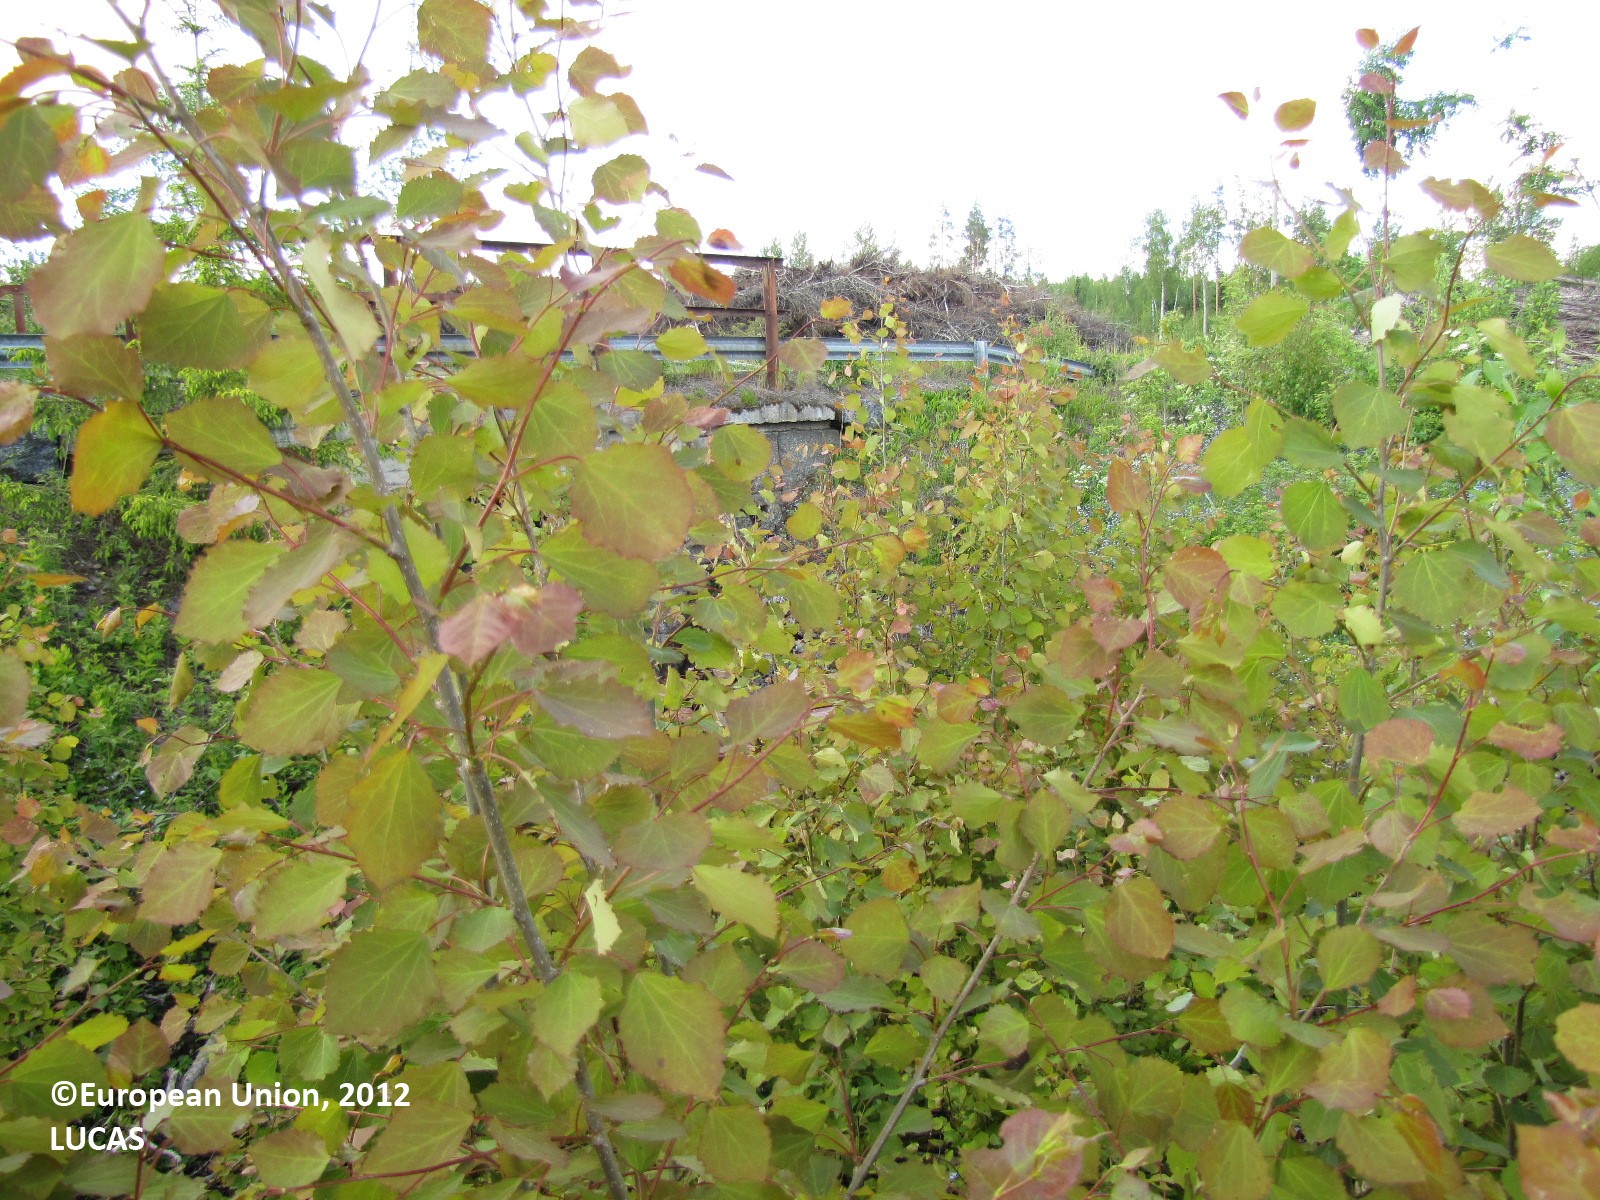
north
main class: Woodland
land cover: Broadleaved woodland
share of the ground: 25 - 50 %
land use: Semi-natural and natural areas not in use
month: June
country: FI
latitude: 61.4213
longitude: 23.0209
